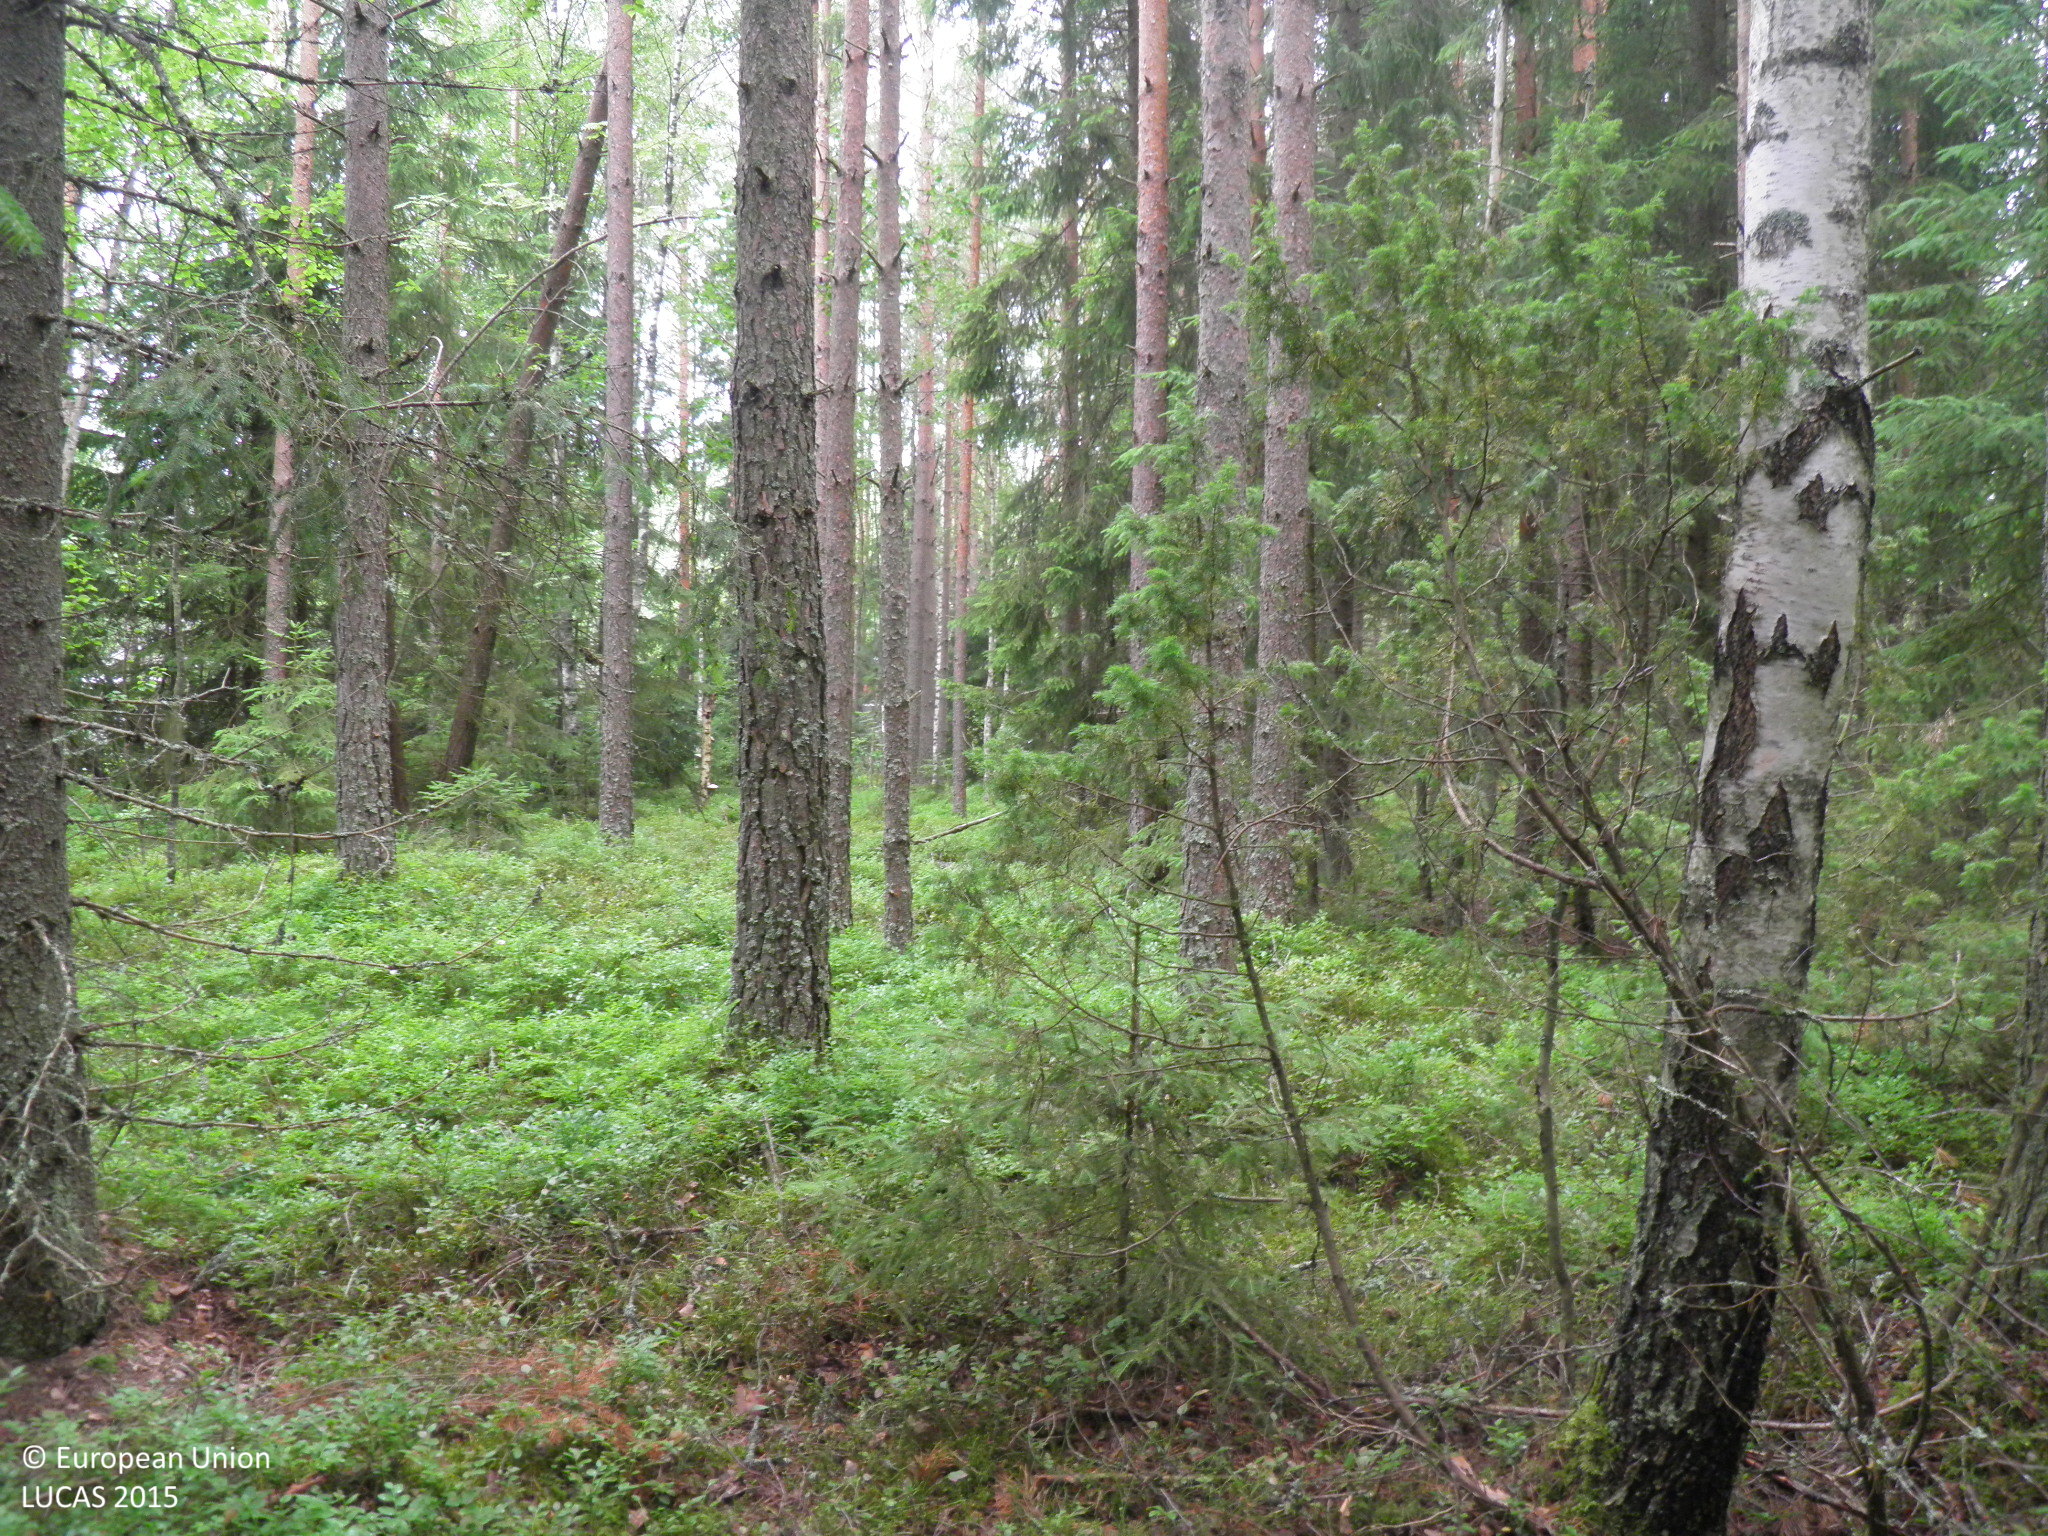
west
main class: Woodland
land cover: Pine dominated mixed woodland
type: hemiboreal forest and nemoral coniferous forest and mixed broadleaved-coniferous forest
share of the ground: 50 - 75 %
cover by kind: broadleaved forest trees 40 %, coniferous forest trees 30 %, shrubs 15 %, herbaceous plants 10 %, lichens and mosses 5 %
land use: Forestry
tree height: > 5 m
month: July
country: FI
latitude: 60.7439
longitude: 22.8223
